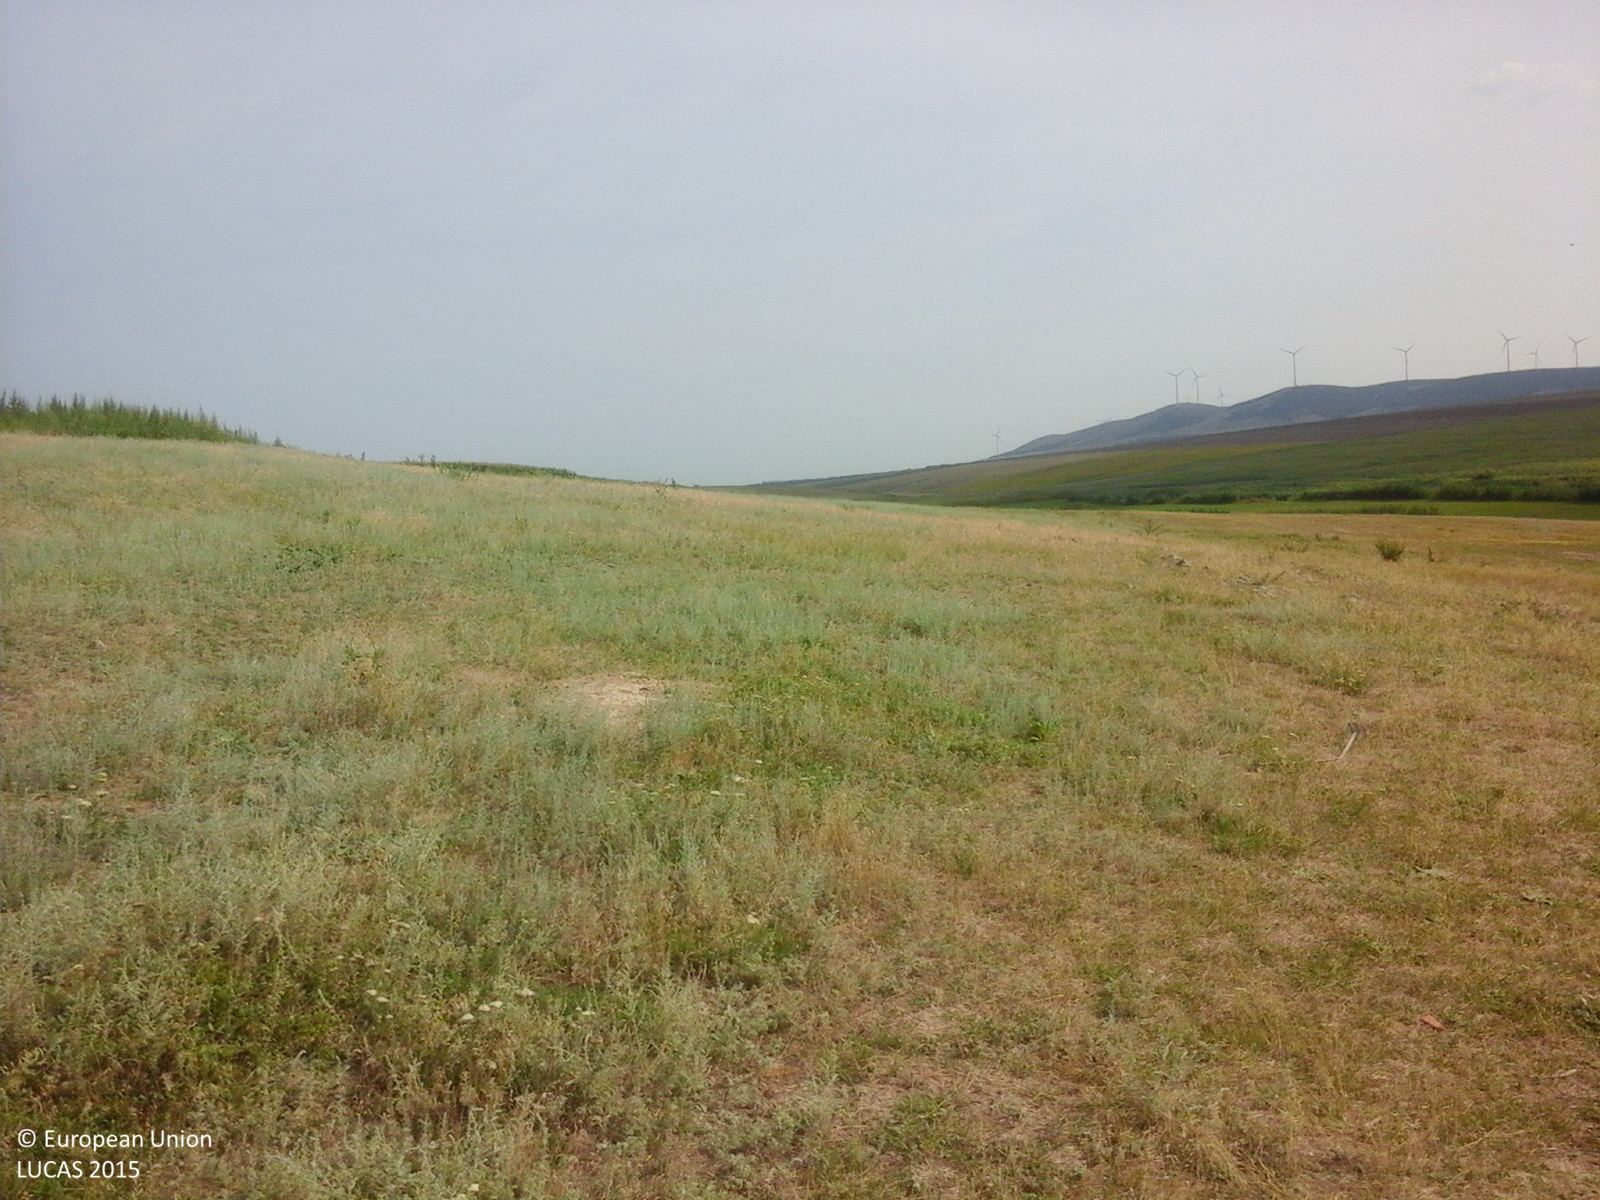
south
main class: Grassland
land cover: Grassland without tree/shrub cover
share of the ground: > 75 %
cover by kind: herbaceous plants 100 %
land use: Agriculture (excluding fallow land and kitchen gardens)
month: July
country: RO
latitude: 45.0795
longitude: 28.8539
